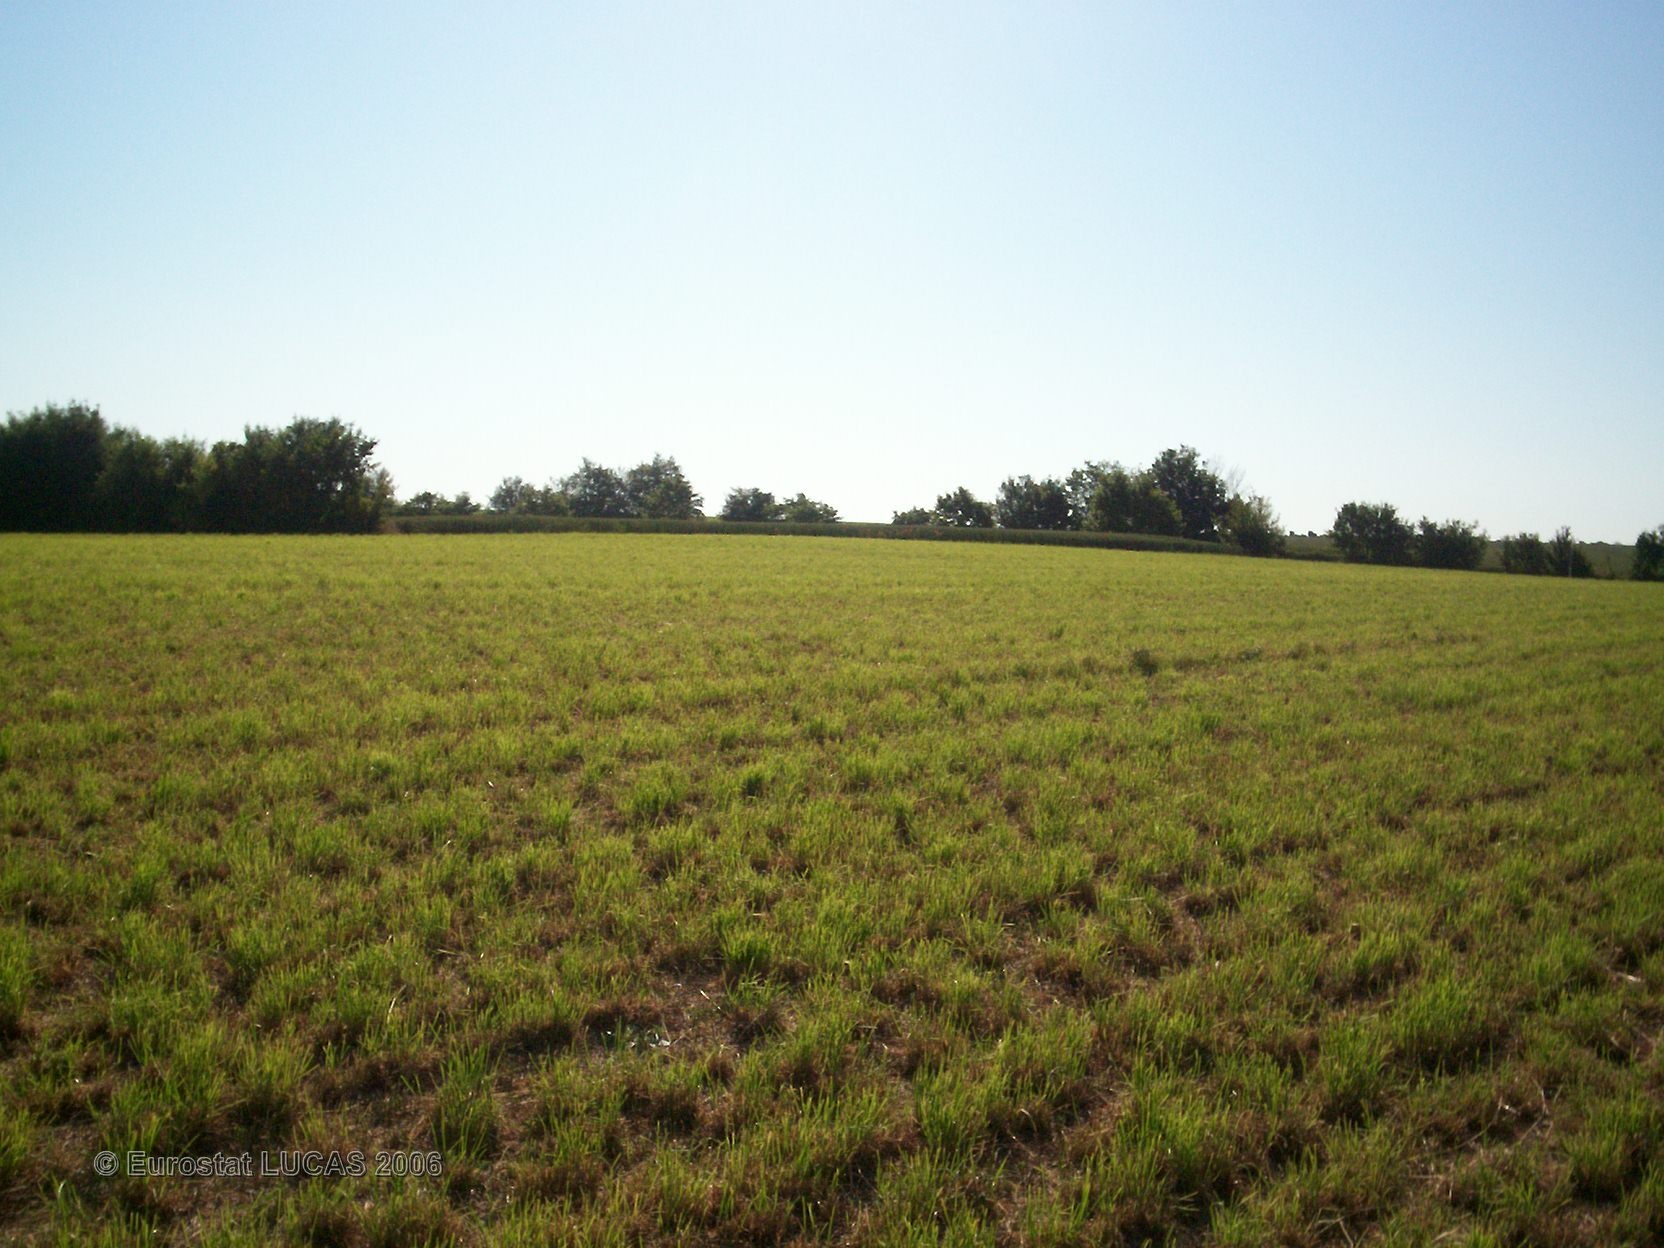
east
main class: Grassland
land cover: Grassland without tree/shrub cover
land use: Agriculture (excluding fallow land and kitchen gardens)
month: June
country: FR
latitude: 46.1570
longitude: -0.7100
